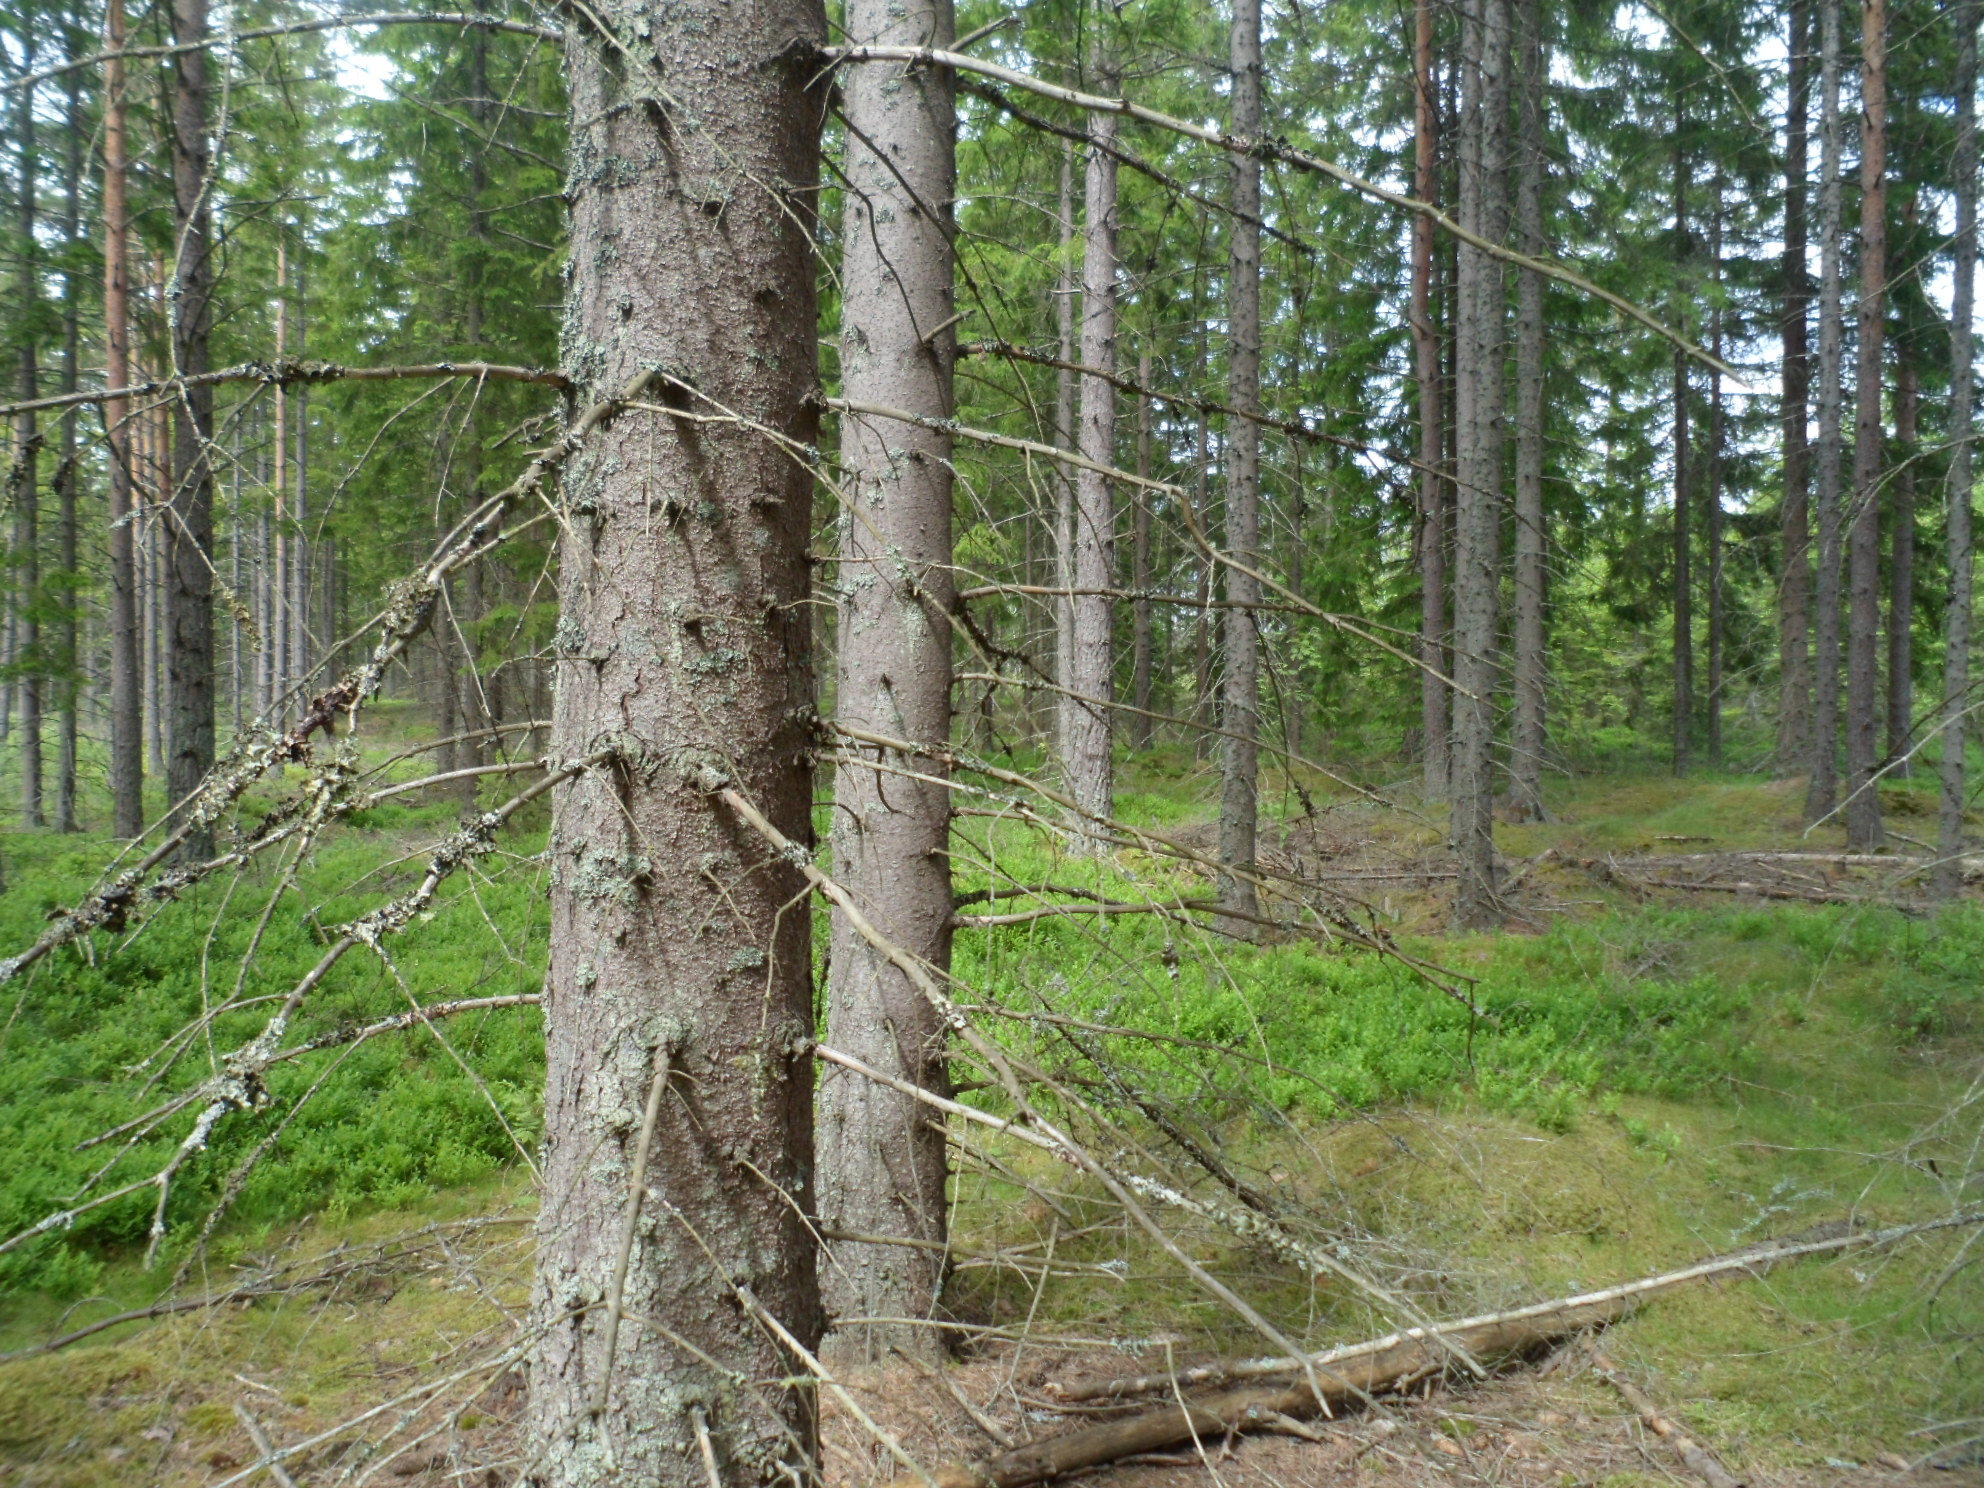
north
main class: Woodland
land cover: Spruce dominated coniferous woodland
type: boreal forest
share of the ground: 50 - 75 %
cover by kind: coniferous forest trees 50 %, lichens and mosses 30 %, shrubs 10 %, herbaceous plants 10 %
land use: Forestry
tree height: > 5 m
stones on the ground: 10 - 25 %
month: June
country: SE
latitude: 56.9377
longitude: 15.4380
